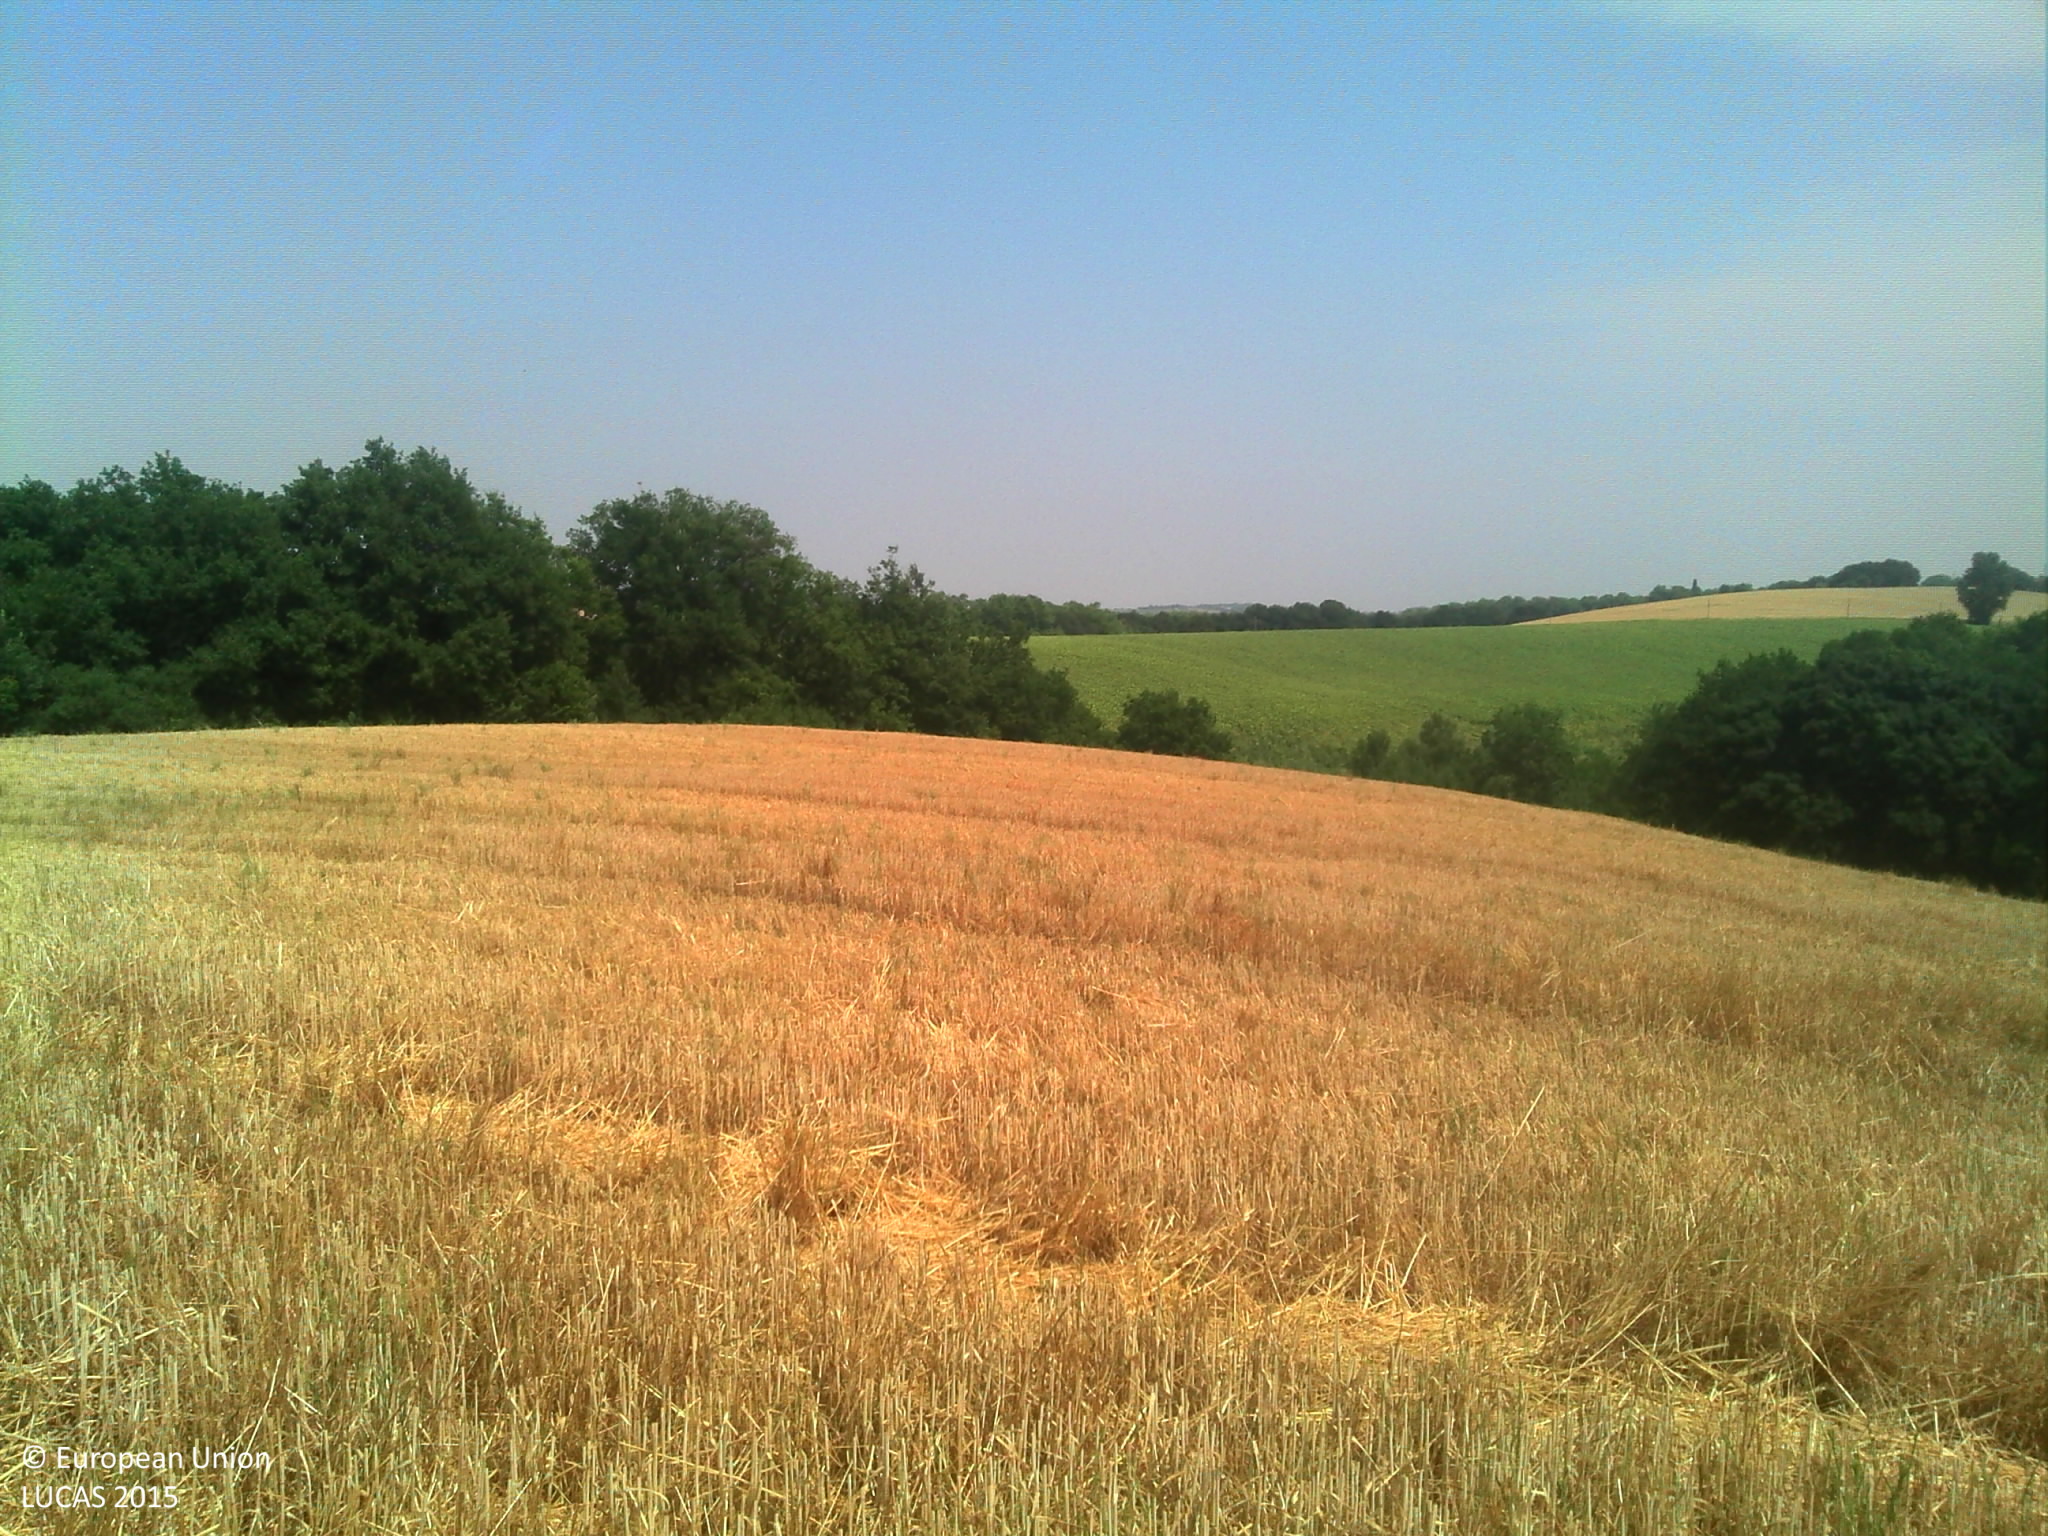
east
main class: Cropland
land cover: Triticale
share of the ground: > 75 %
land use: Agriculture (excluding fallow land and kitchen gardens)
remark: Harvested field
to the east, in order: Triticale; Broadleaved woodland; Grassland without tree/shrub cover; Broadleaved woodland; Ditches and canals; Broadleaved woodland; Grassland without tree/shrub cover
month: July
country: FR
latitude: 43.3032
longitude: 1.6099
